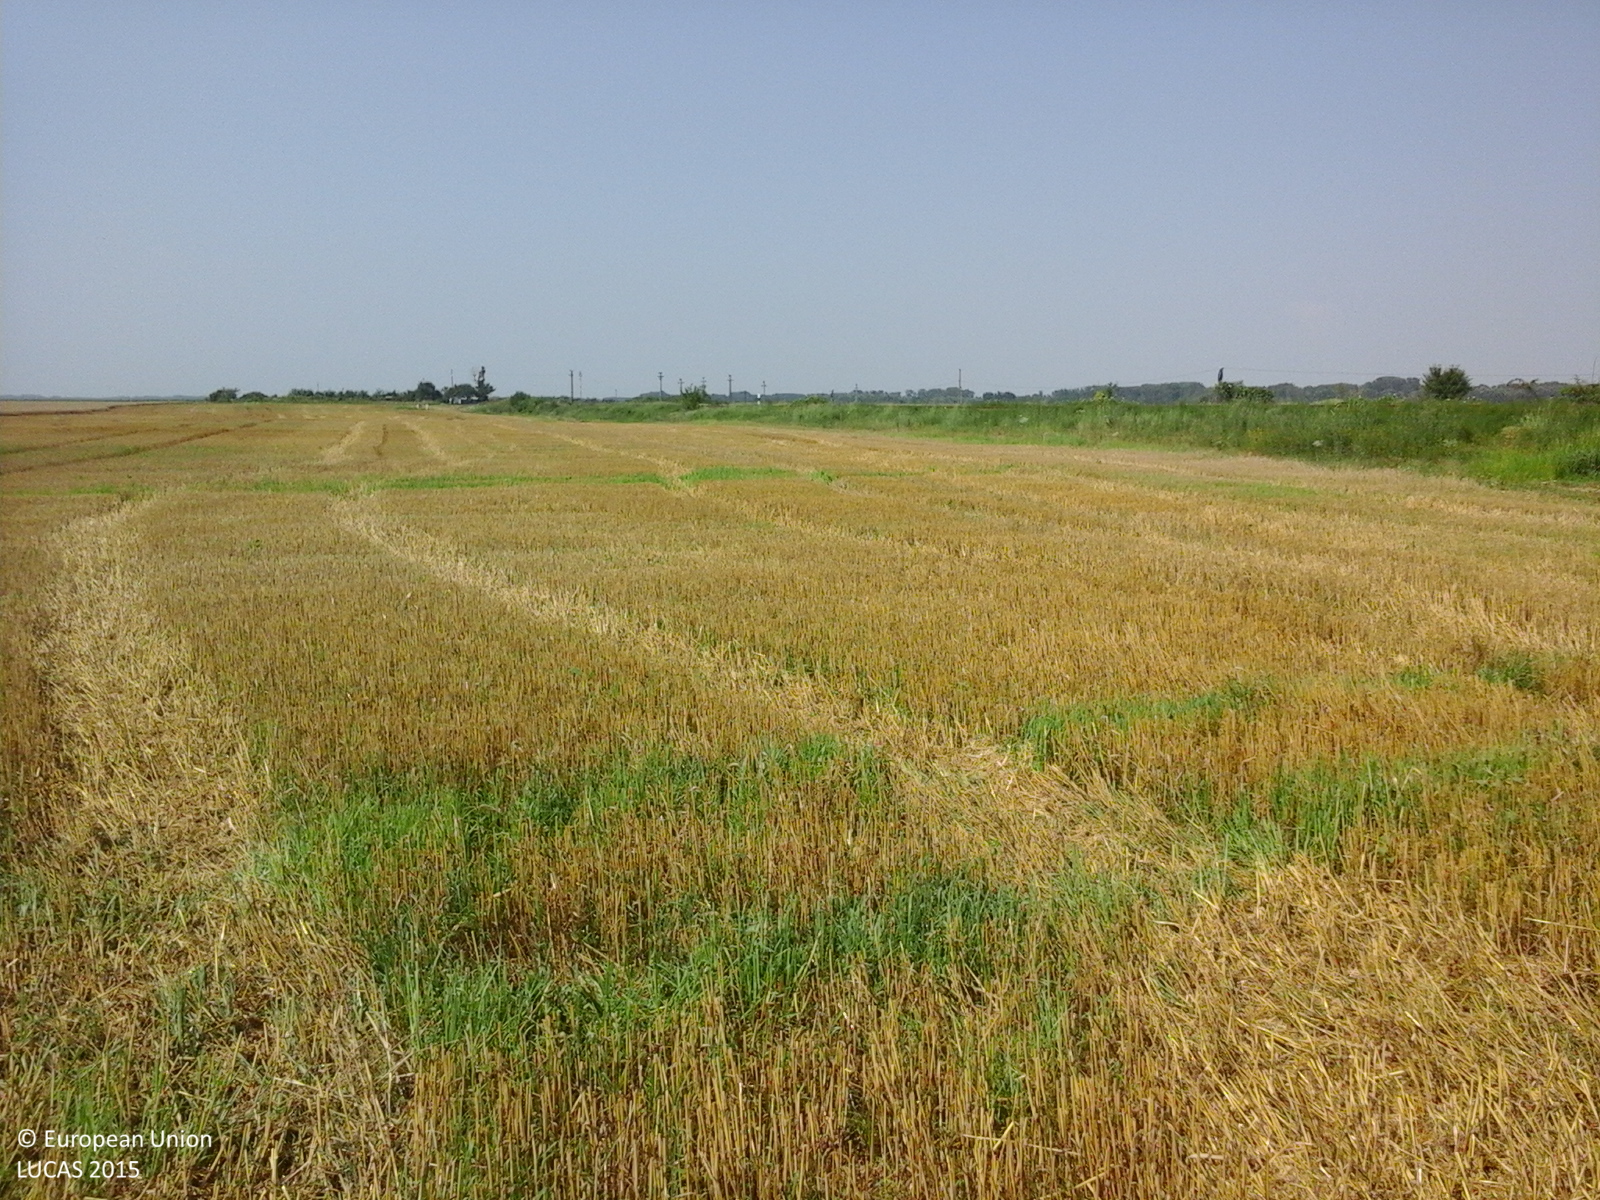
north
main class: Cropland
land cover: Common wheat
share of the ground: < 10 %
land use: Agriculture (excluding fallow land and kitchen gardens)
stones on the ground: < 10 %
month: July
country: RO
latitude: 44.7091
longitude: 25.5572
